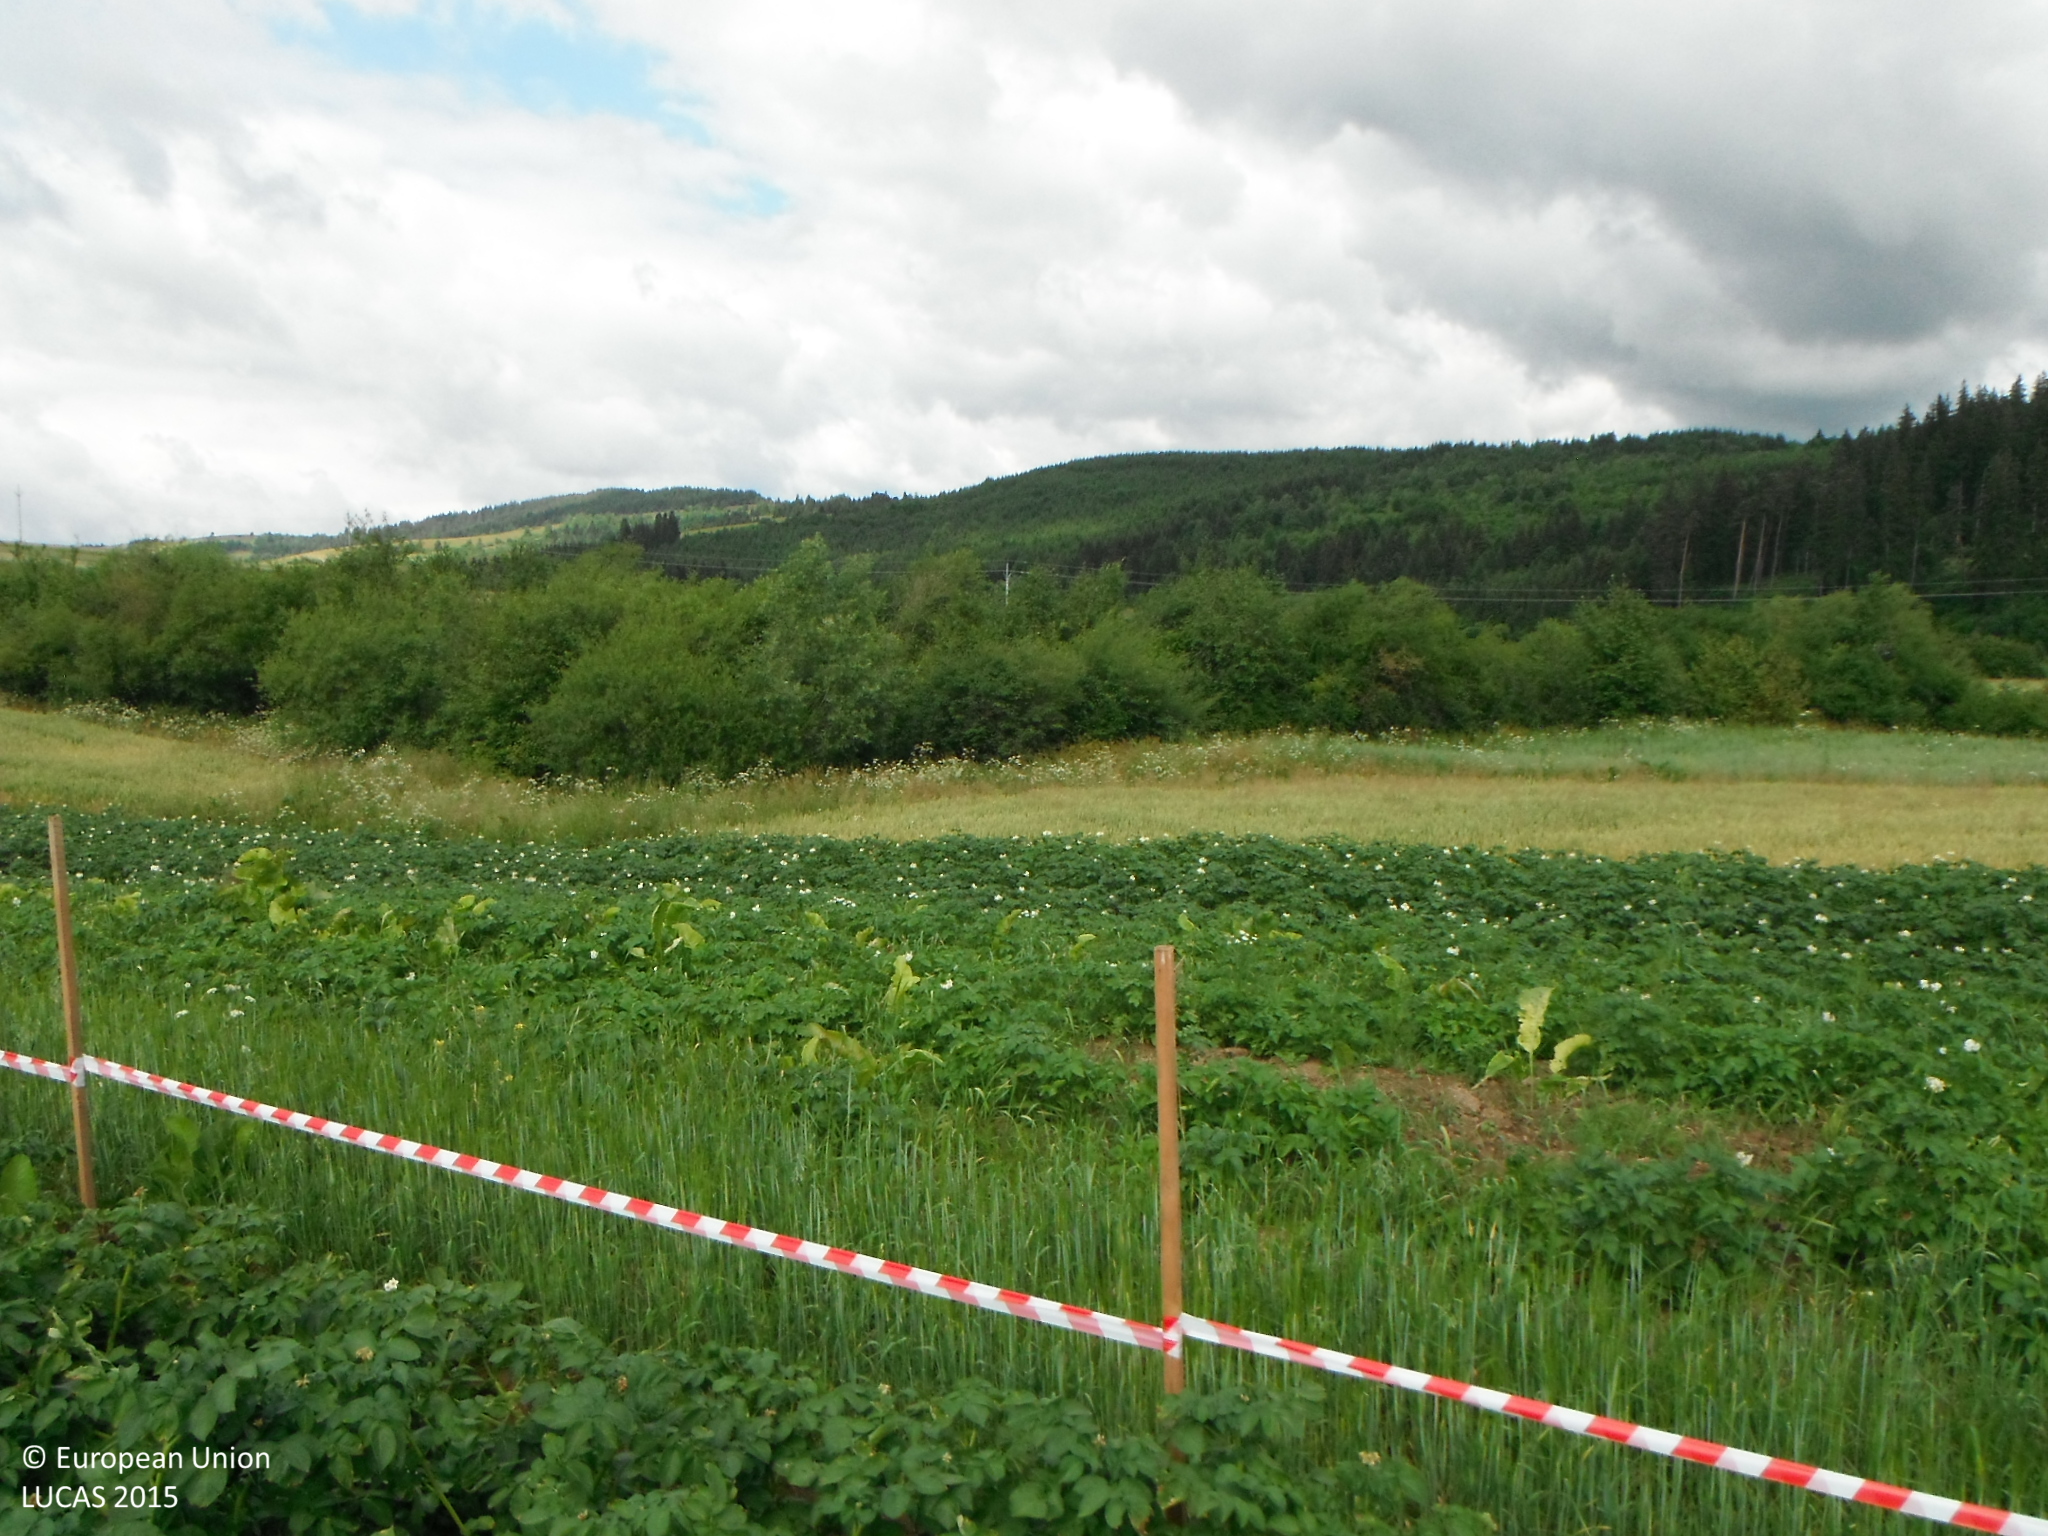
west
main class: Cropland
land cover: Potatoes
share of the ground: > 75 %
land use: Agriculture (excluding fallow land and kitchen gardens)
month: July
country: SK
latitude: 49.3604
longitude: 19.4021
